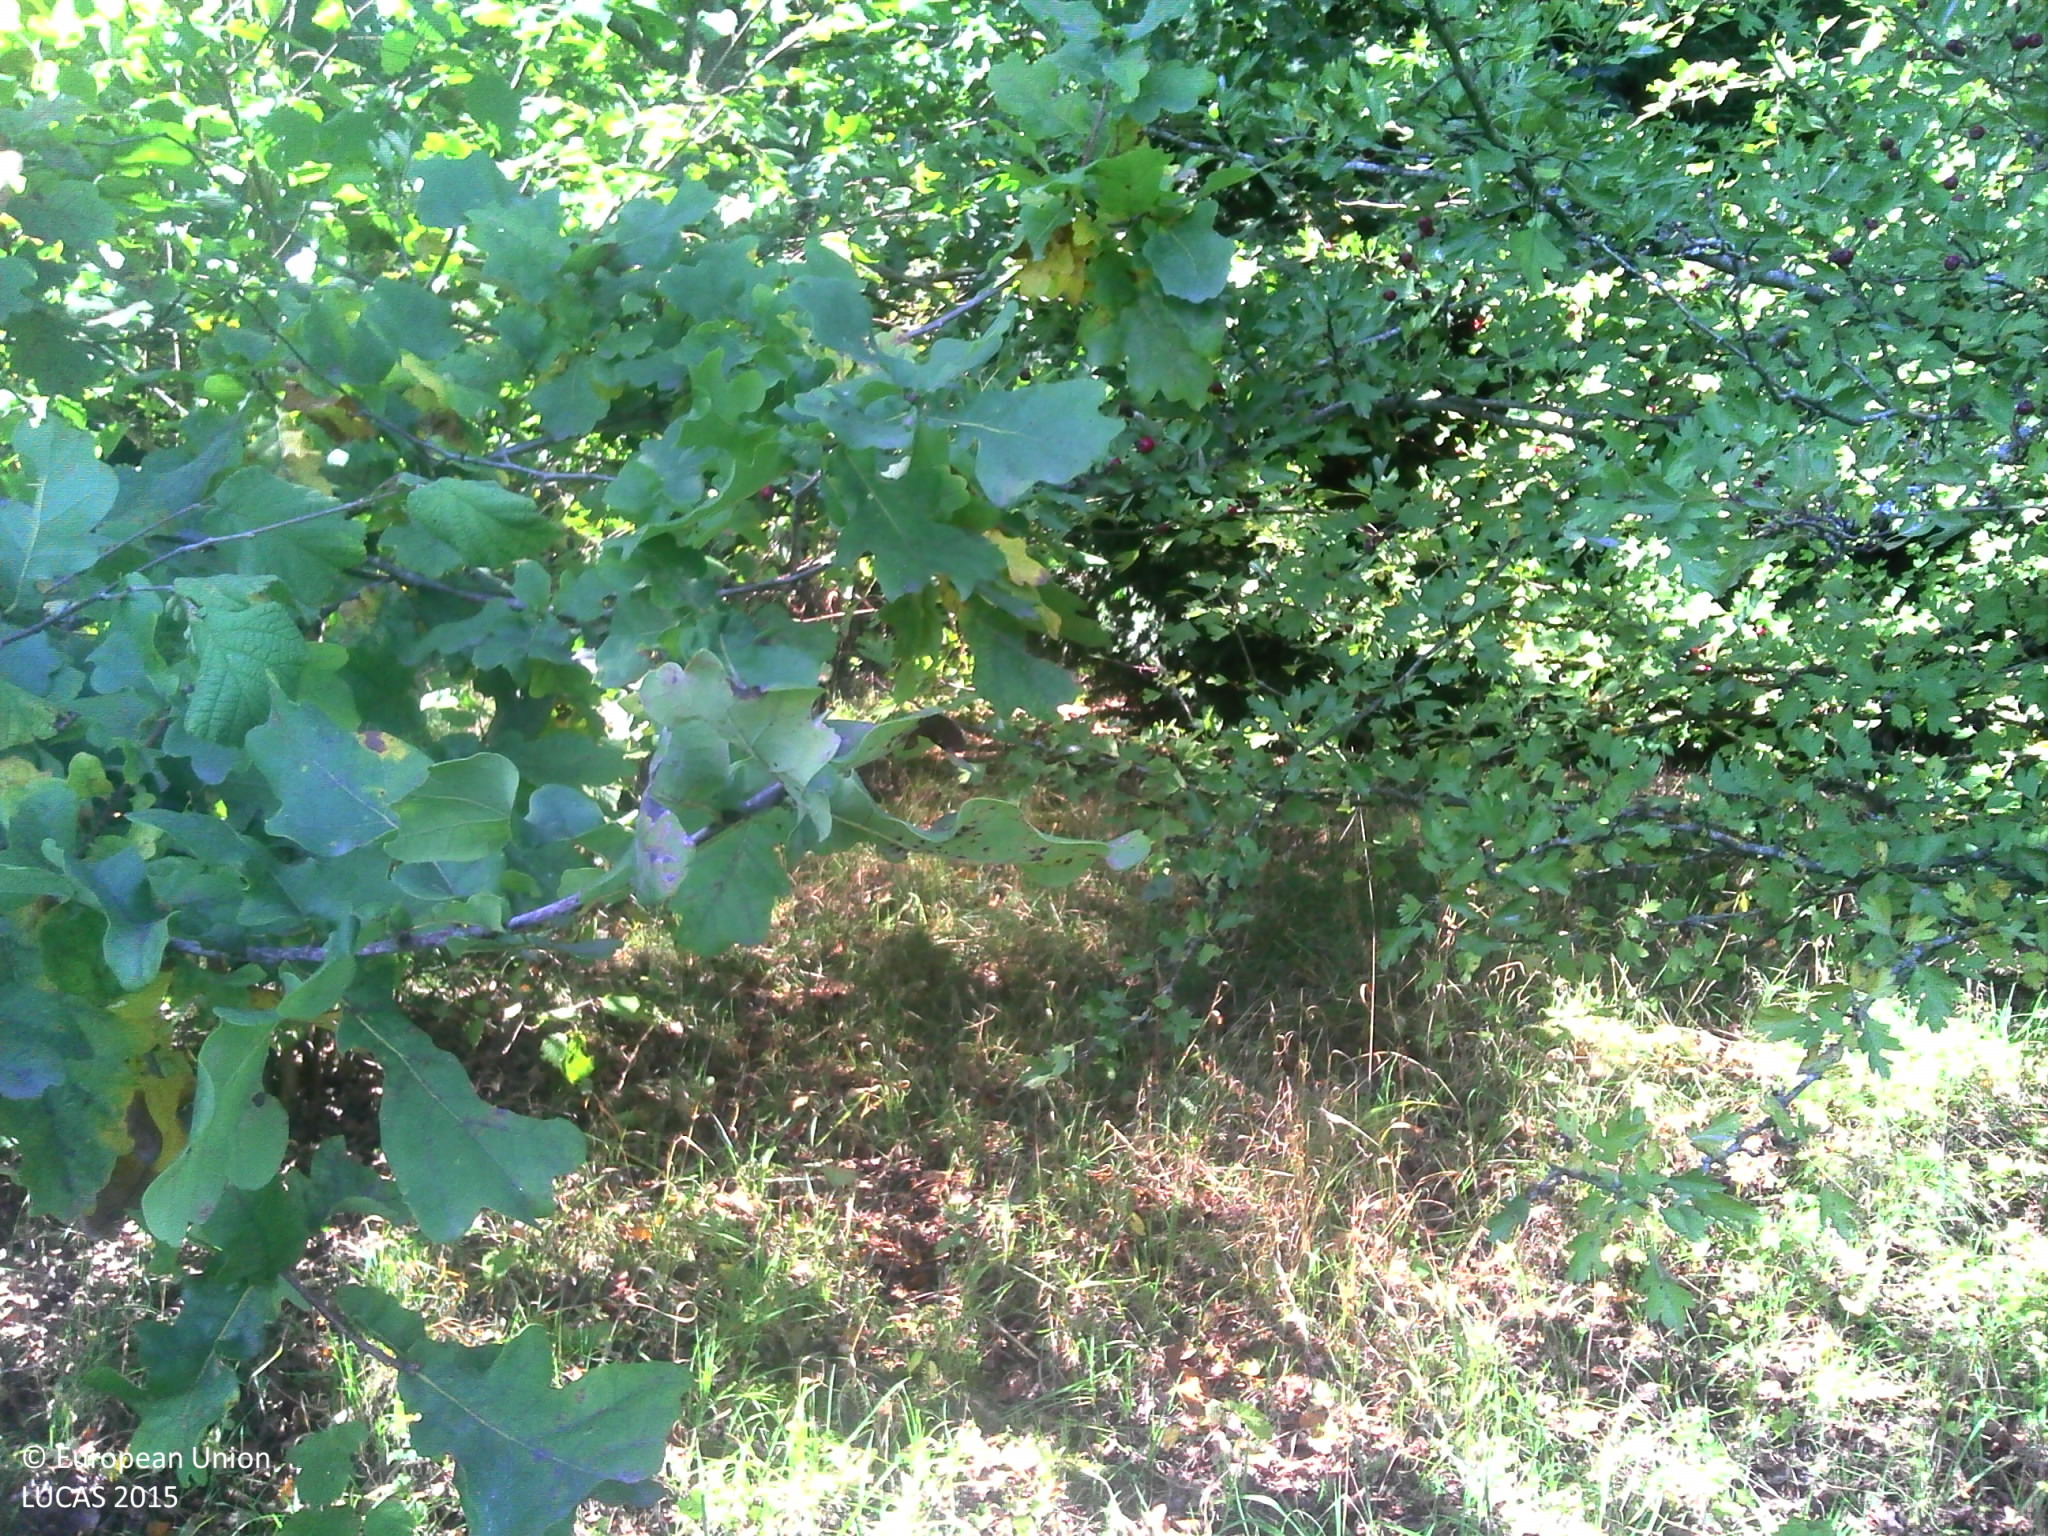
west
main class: Grassland
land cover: Grassland without tree/shrub cover
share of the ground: > 75 %
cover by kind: herbaceous plants 100 %
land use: Agriculture (excluding fallow land and kitchen gardens)
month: October
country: FR
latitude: 48.7195
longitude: 6.2893
